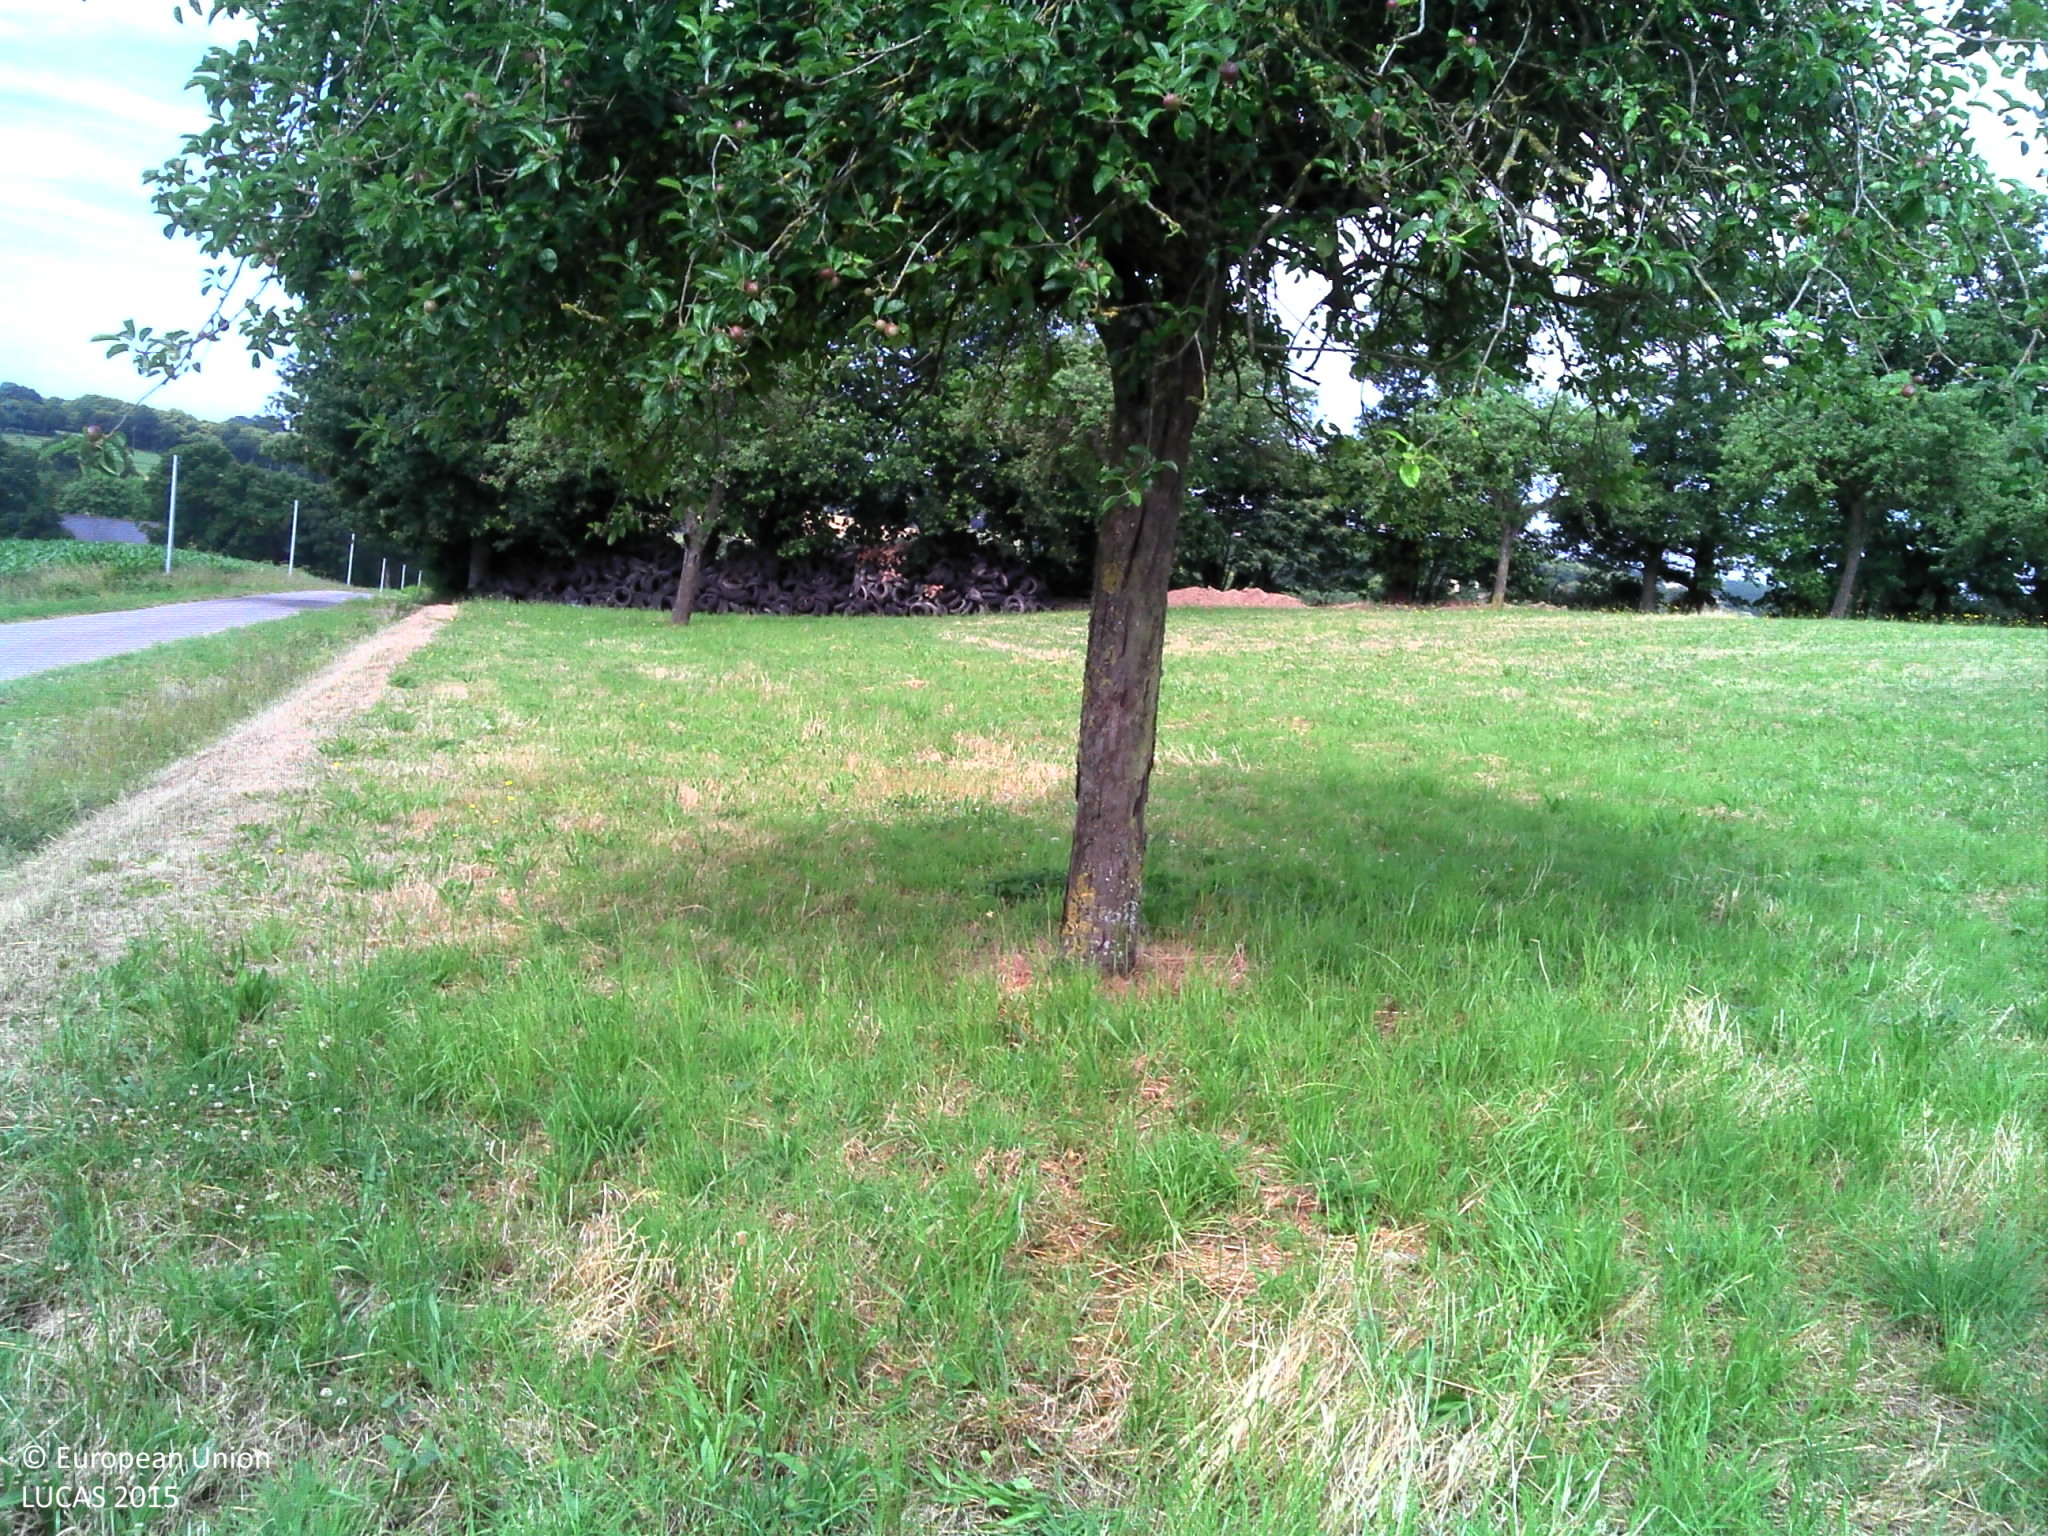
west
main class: Cropland
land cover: Apple fruit
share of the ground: > 75 %
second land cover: Grassland without tree/shrub cover
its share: > 75 %
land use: Agriculture (excluding fallow land and kitchen gardens)
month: June
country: FR
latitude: 47.9362
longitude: -1.5984
